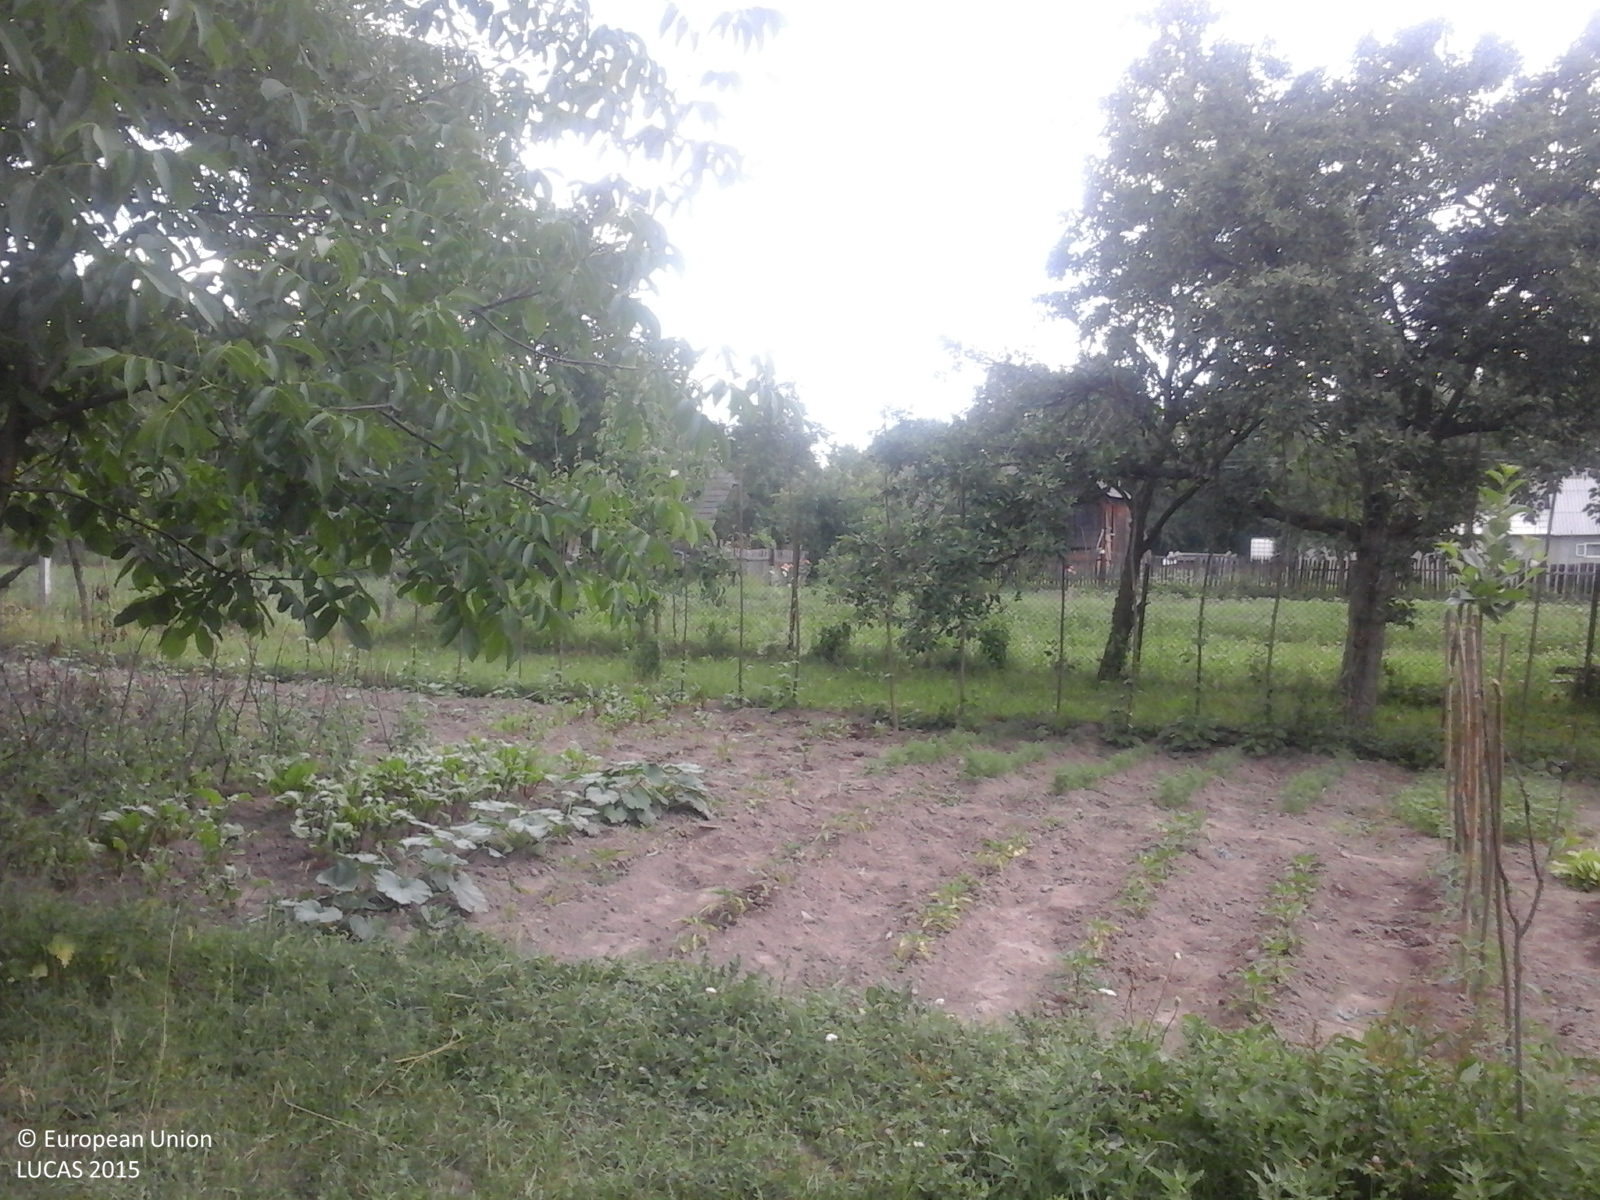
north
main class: Grassland
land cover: Grassland without tree/shrub cover
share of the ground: 50 - 75 %
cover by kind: herbaceous plants 100 %
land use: Agriculture (excluding fallow land and kitchen gardens)
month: June
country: RO
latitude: 47.6425
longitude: 25.9281
